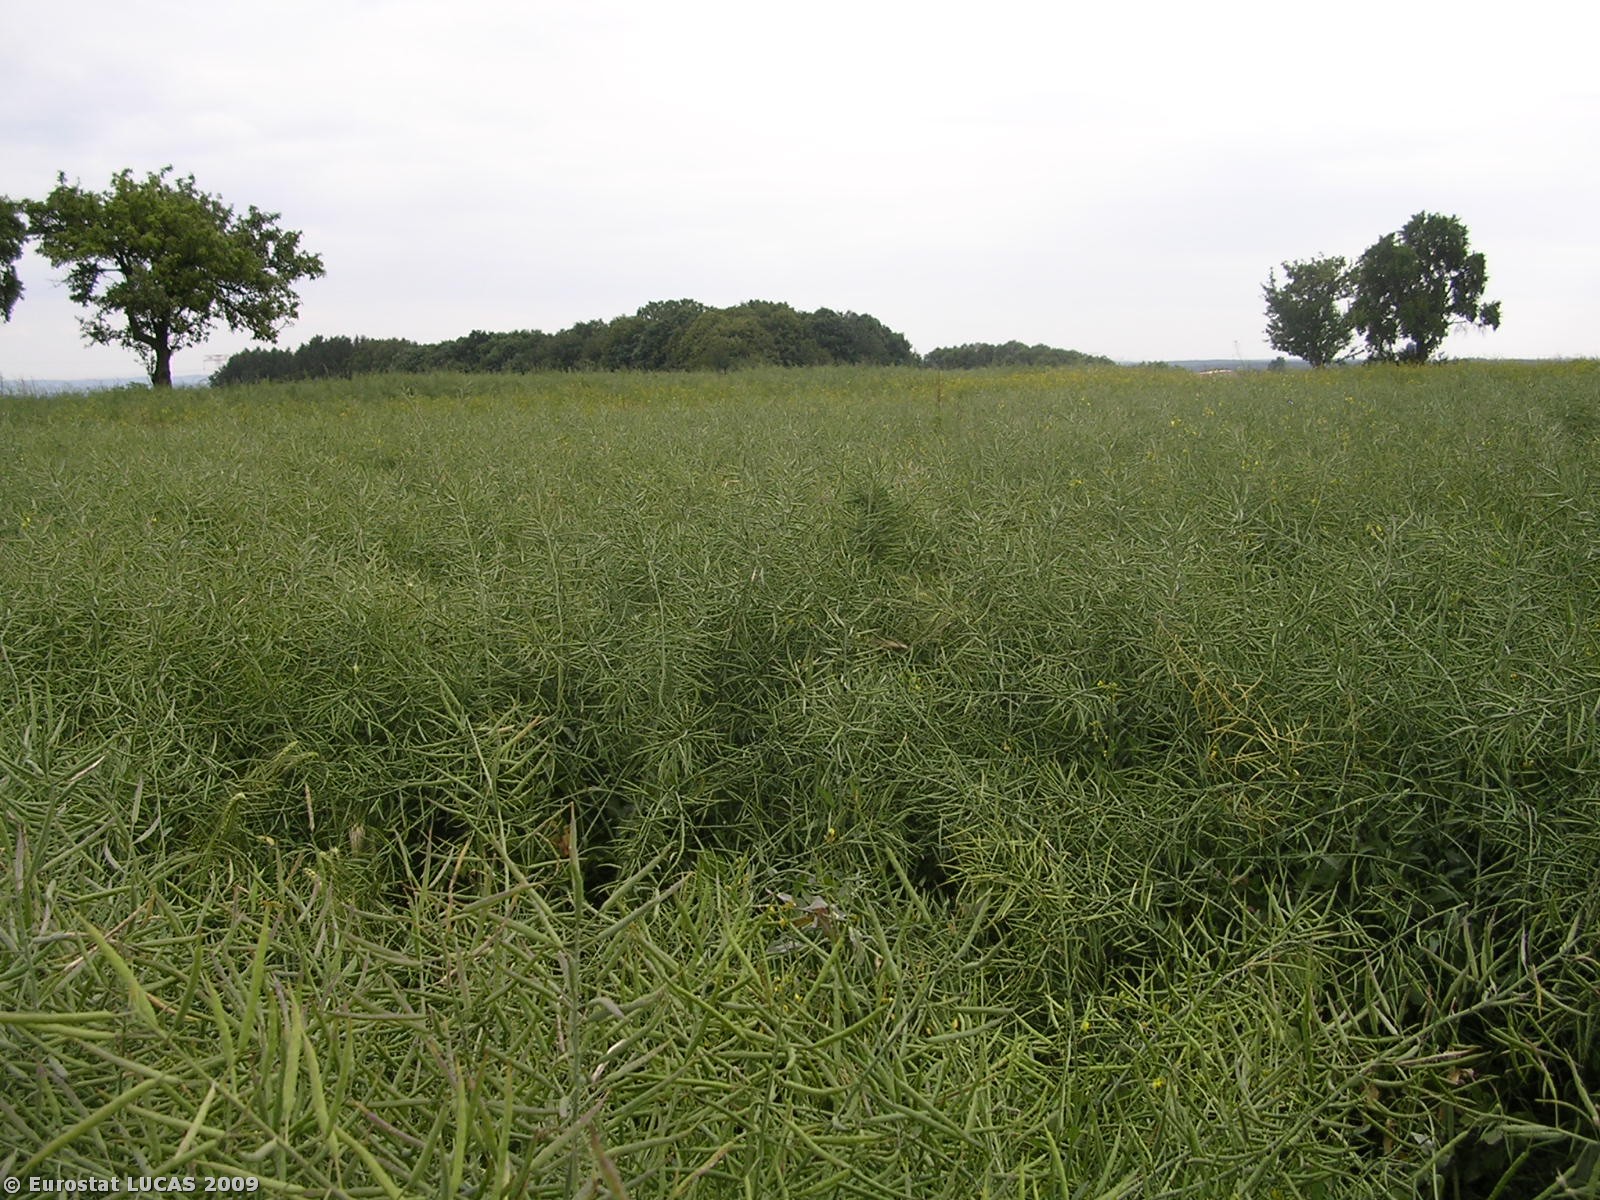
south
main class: Cropland
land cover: Rape and turnip rape
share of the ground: > 75 %
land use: Agriculture (excluding fallow land and kitchen gardens)
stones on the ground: < 10 %
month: June
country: CZ
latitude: 50.5629
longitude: 14.9579
